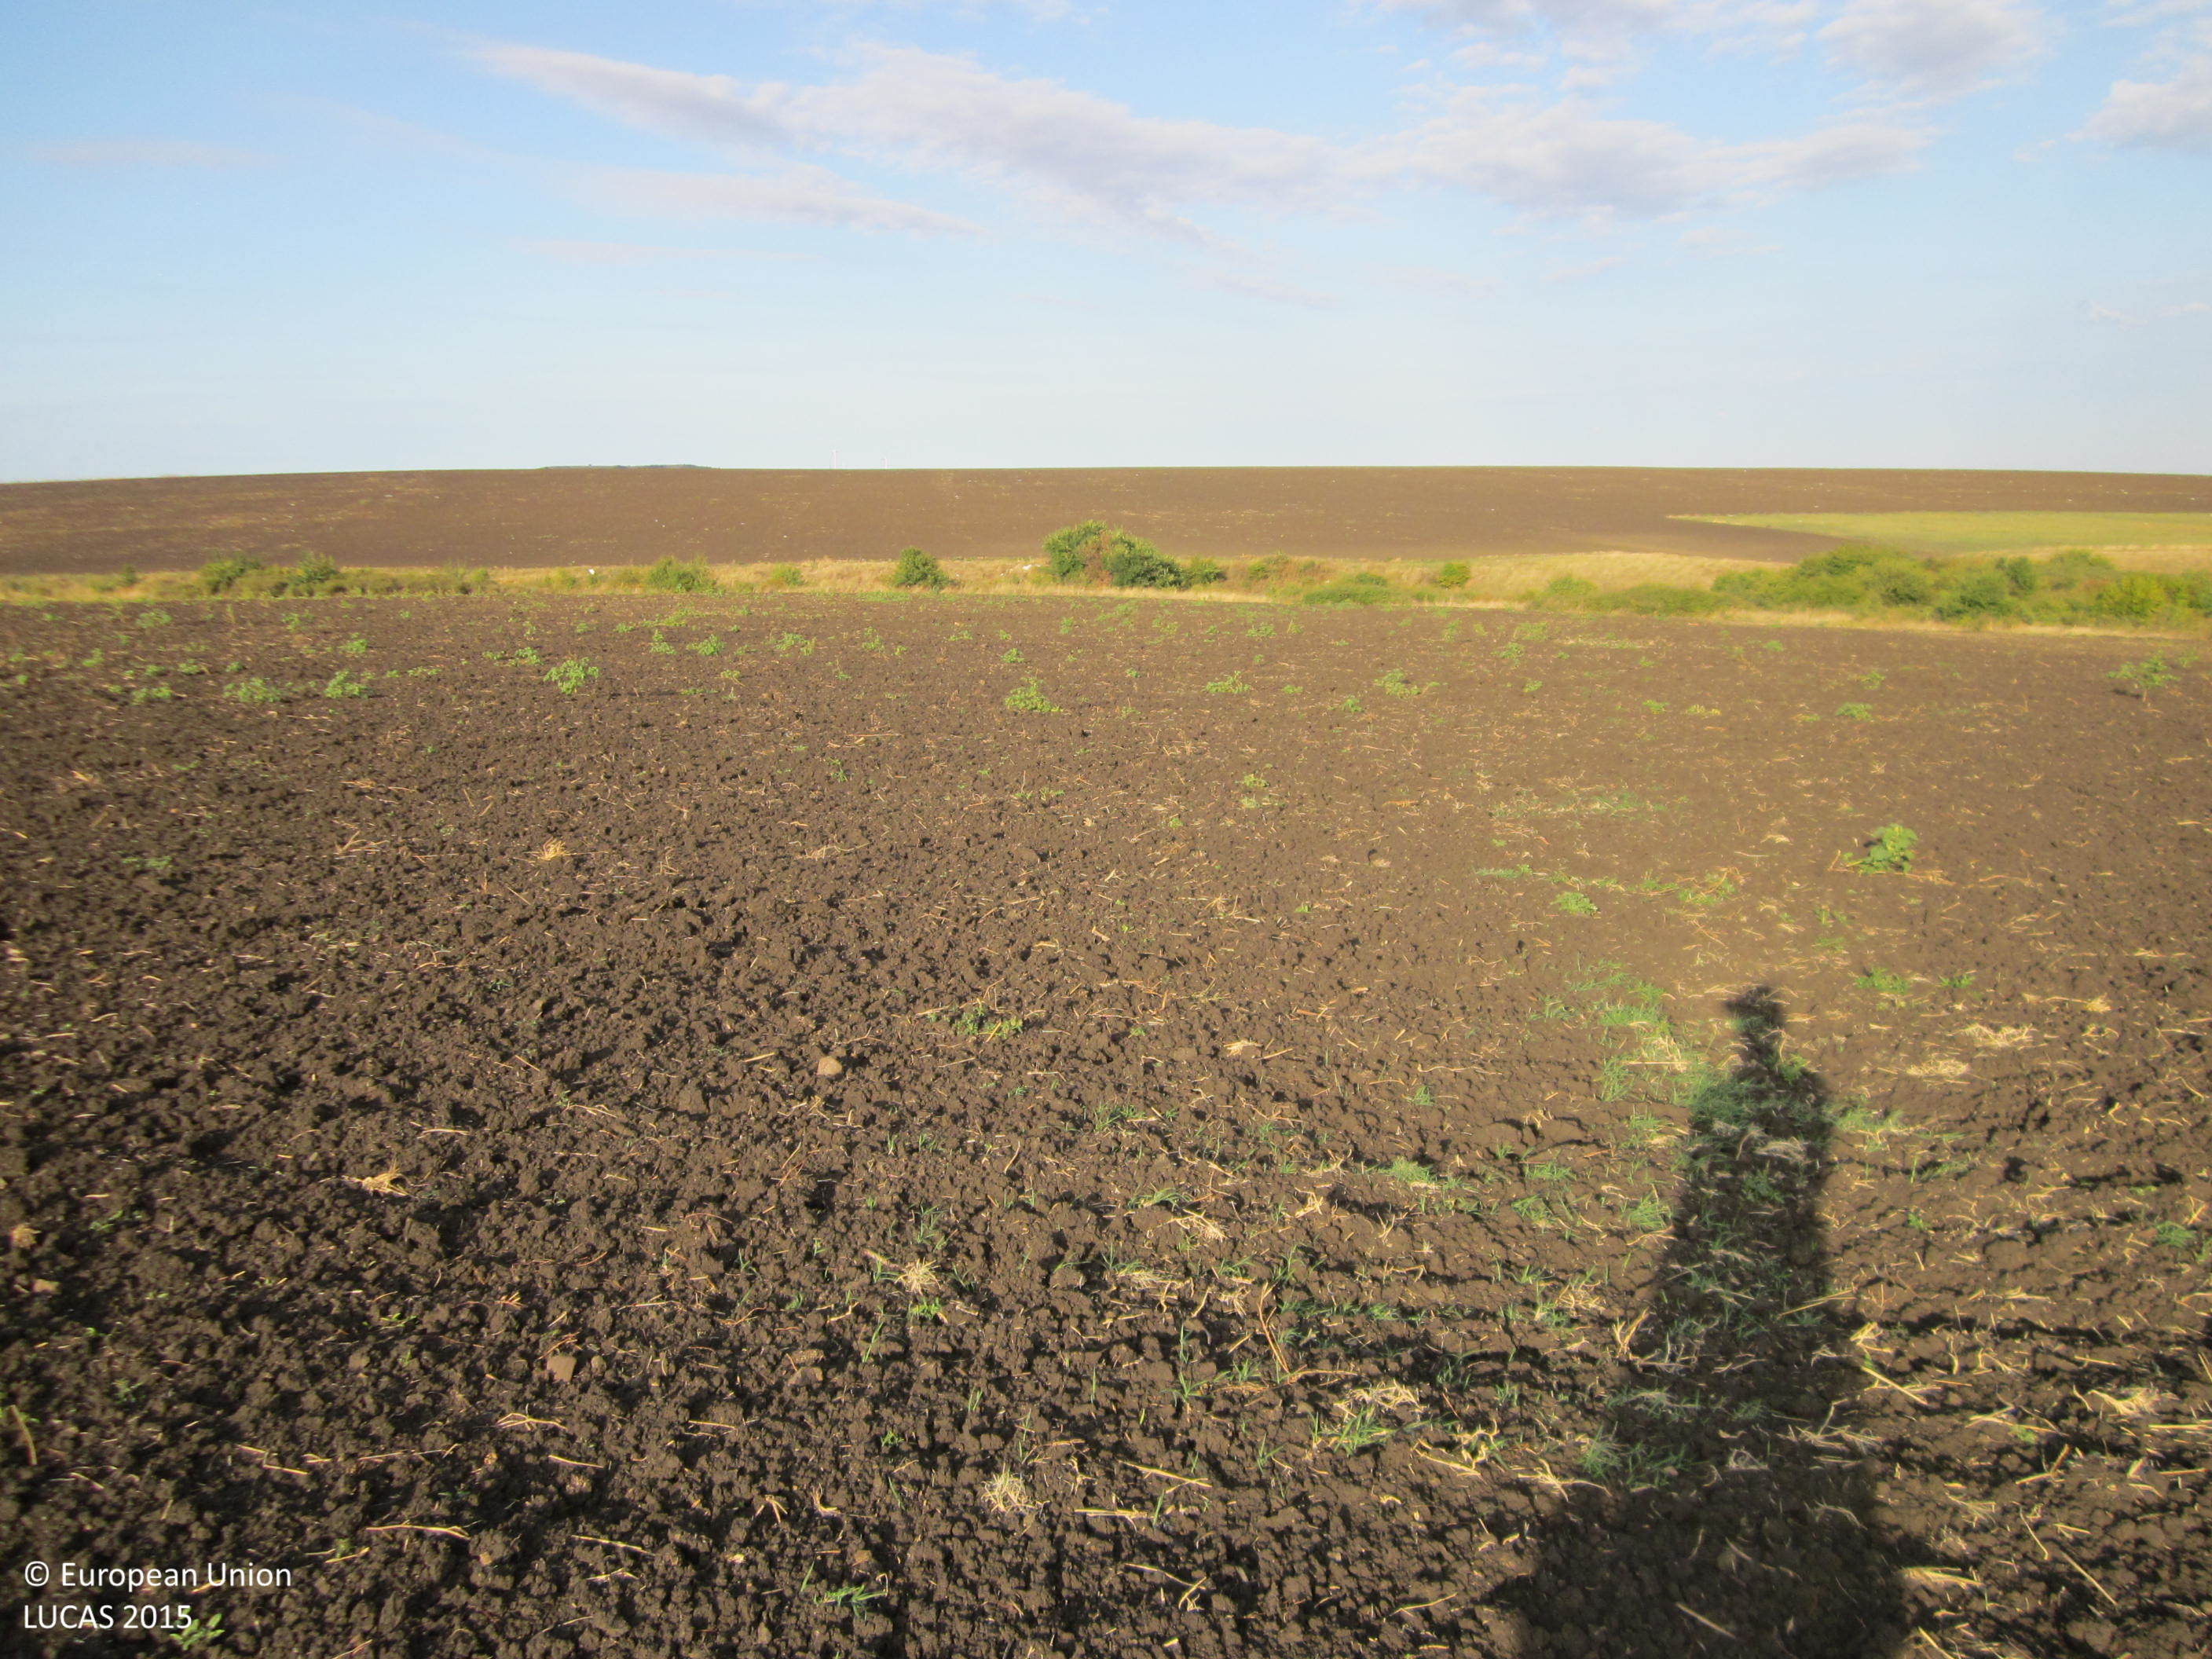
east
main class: Cropland
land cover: Sunflower
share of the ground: < 10 %
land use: Agriculture (excluding fallow land and kitchen gardens)
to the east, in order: Sunflower; Grass margins; Shrubland with sparse tree cover; Rivers and streams; Shrubland with sparse tree cover; Grassland without tree/shrub cover; Tracks; Grassland without tree/shrub cover
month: September
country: BG
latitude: 42.6207
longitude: 27.1171
